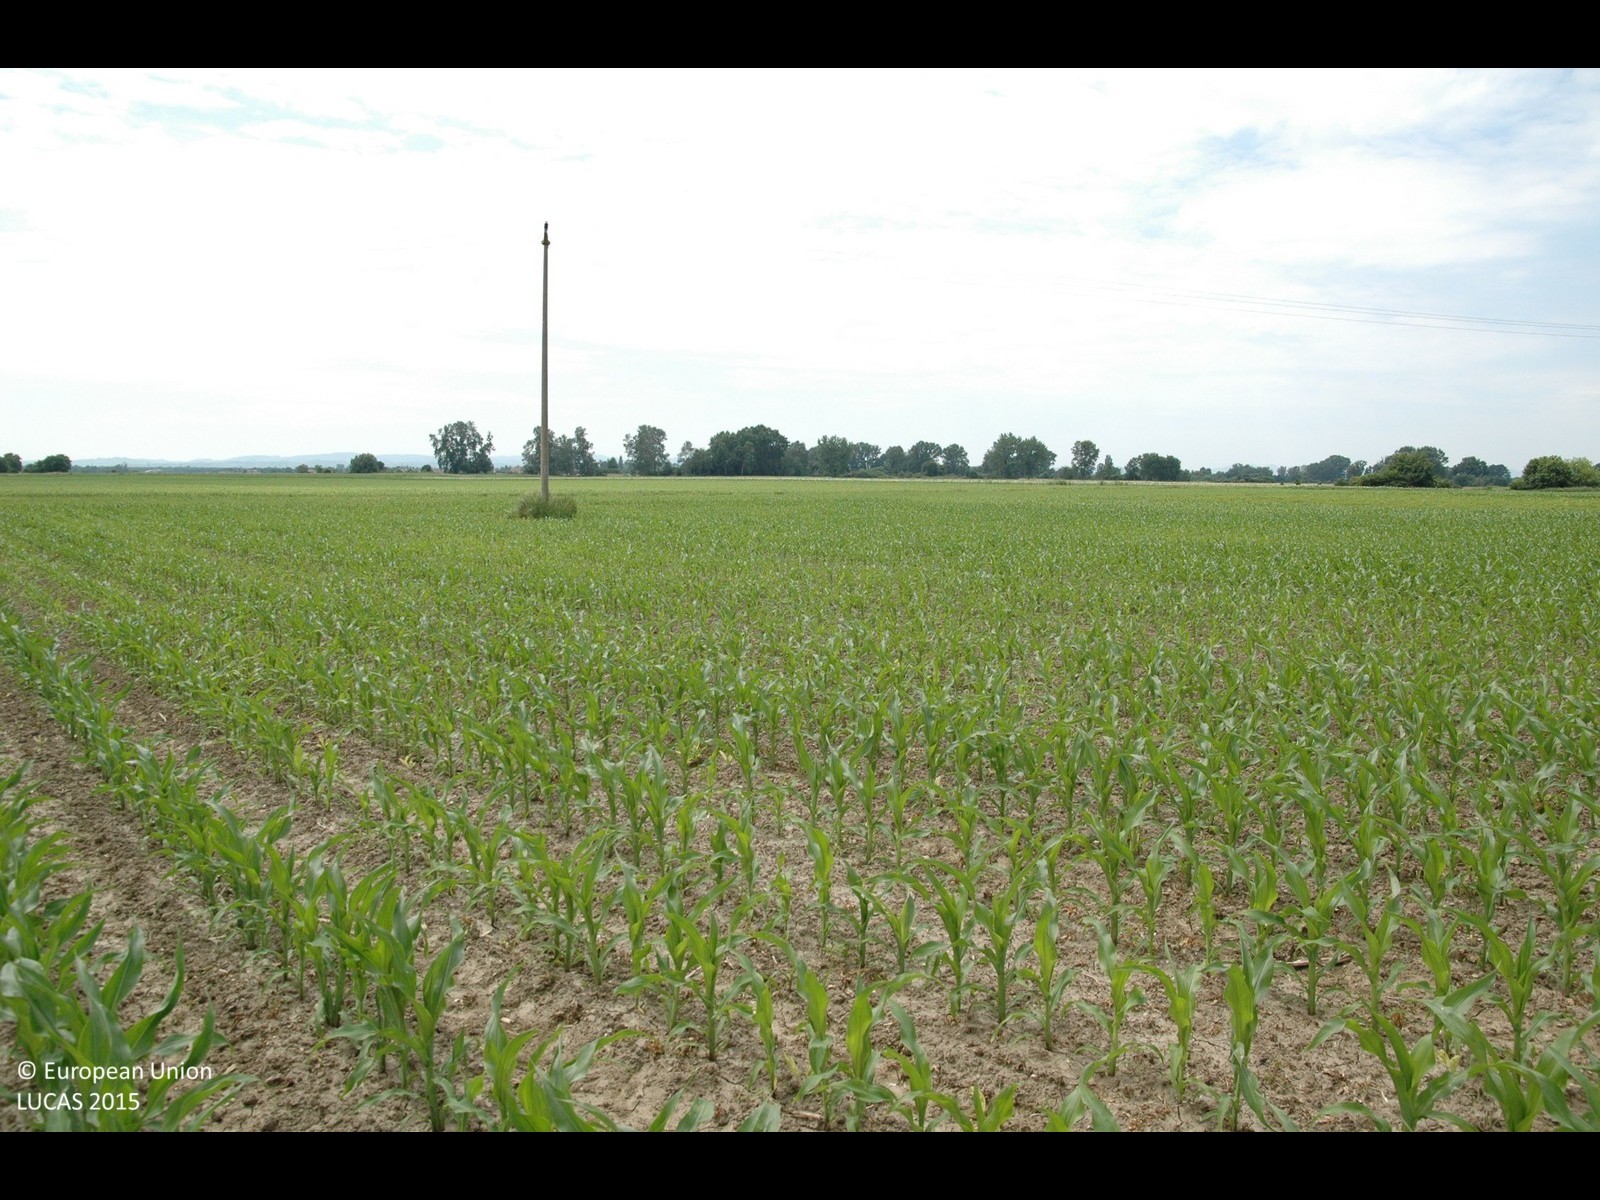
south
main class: Cropland
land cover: Maize
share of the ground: 25 - 50 %
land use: Agriculture (excluding fallow land and kitchen gardens)
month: May
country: HR
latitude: 46.3515
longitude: 16.5112
